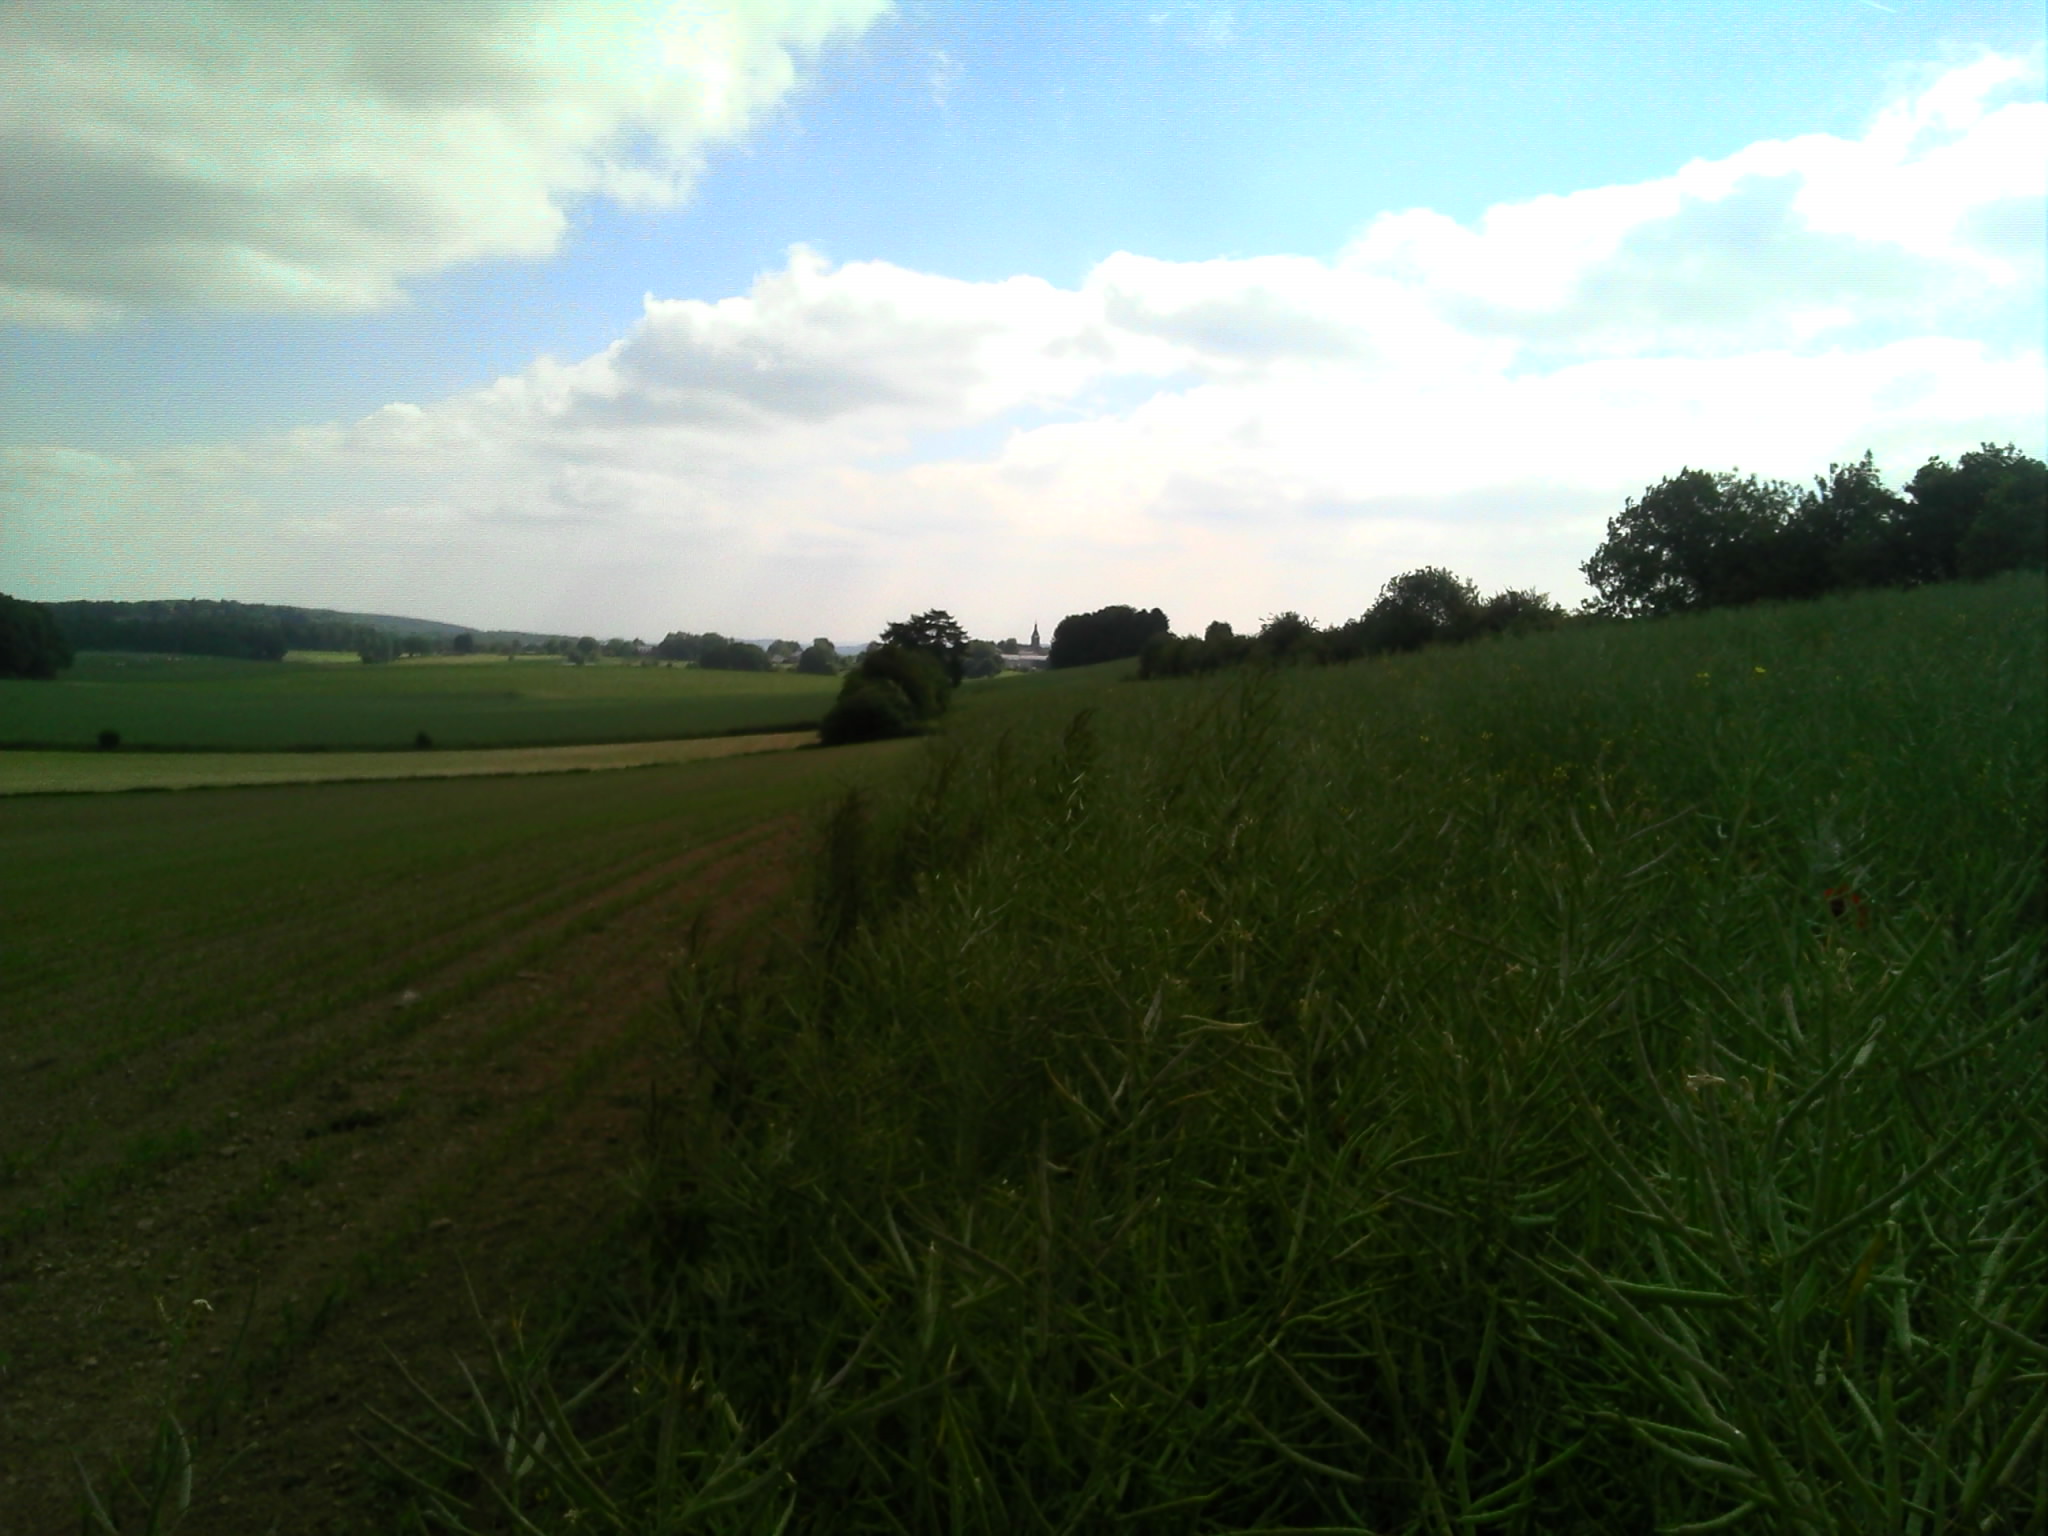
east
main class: Cropland
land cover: Rape and turnip rape
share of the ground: > 75 %
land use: Agriculture (excluding fallow land and kitchen gardens)
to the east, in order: Rape and turnip rape
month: June
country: BE
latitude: 50.3583
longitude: 5.3172
